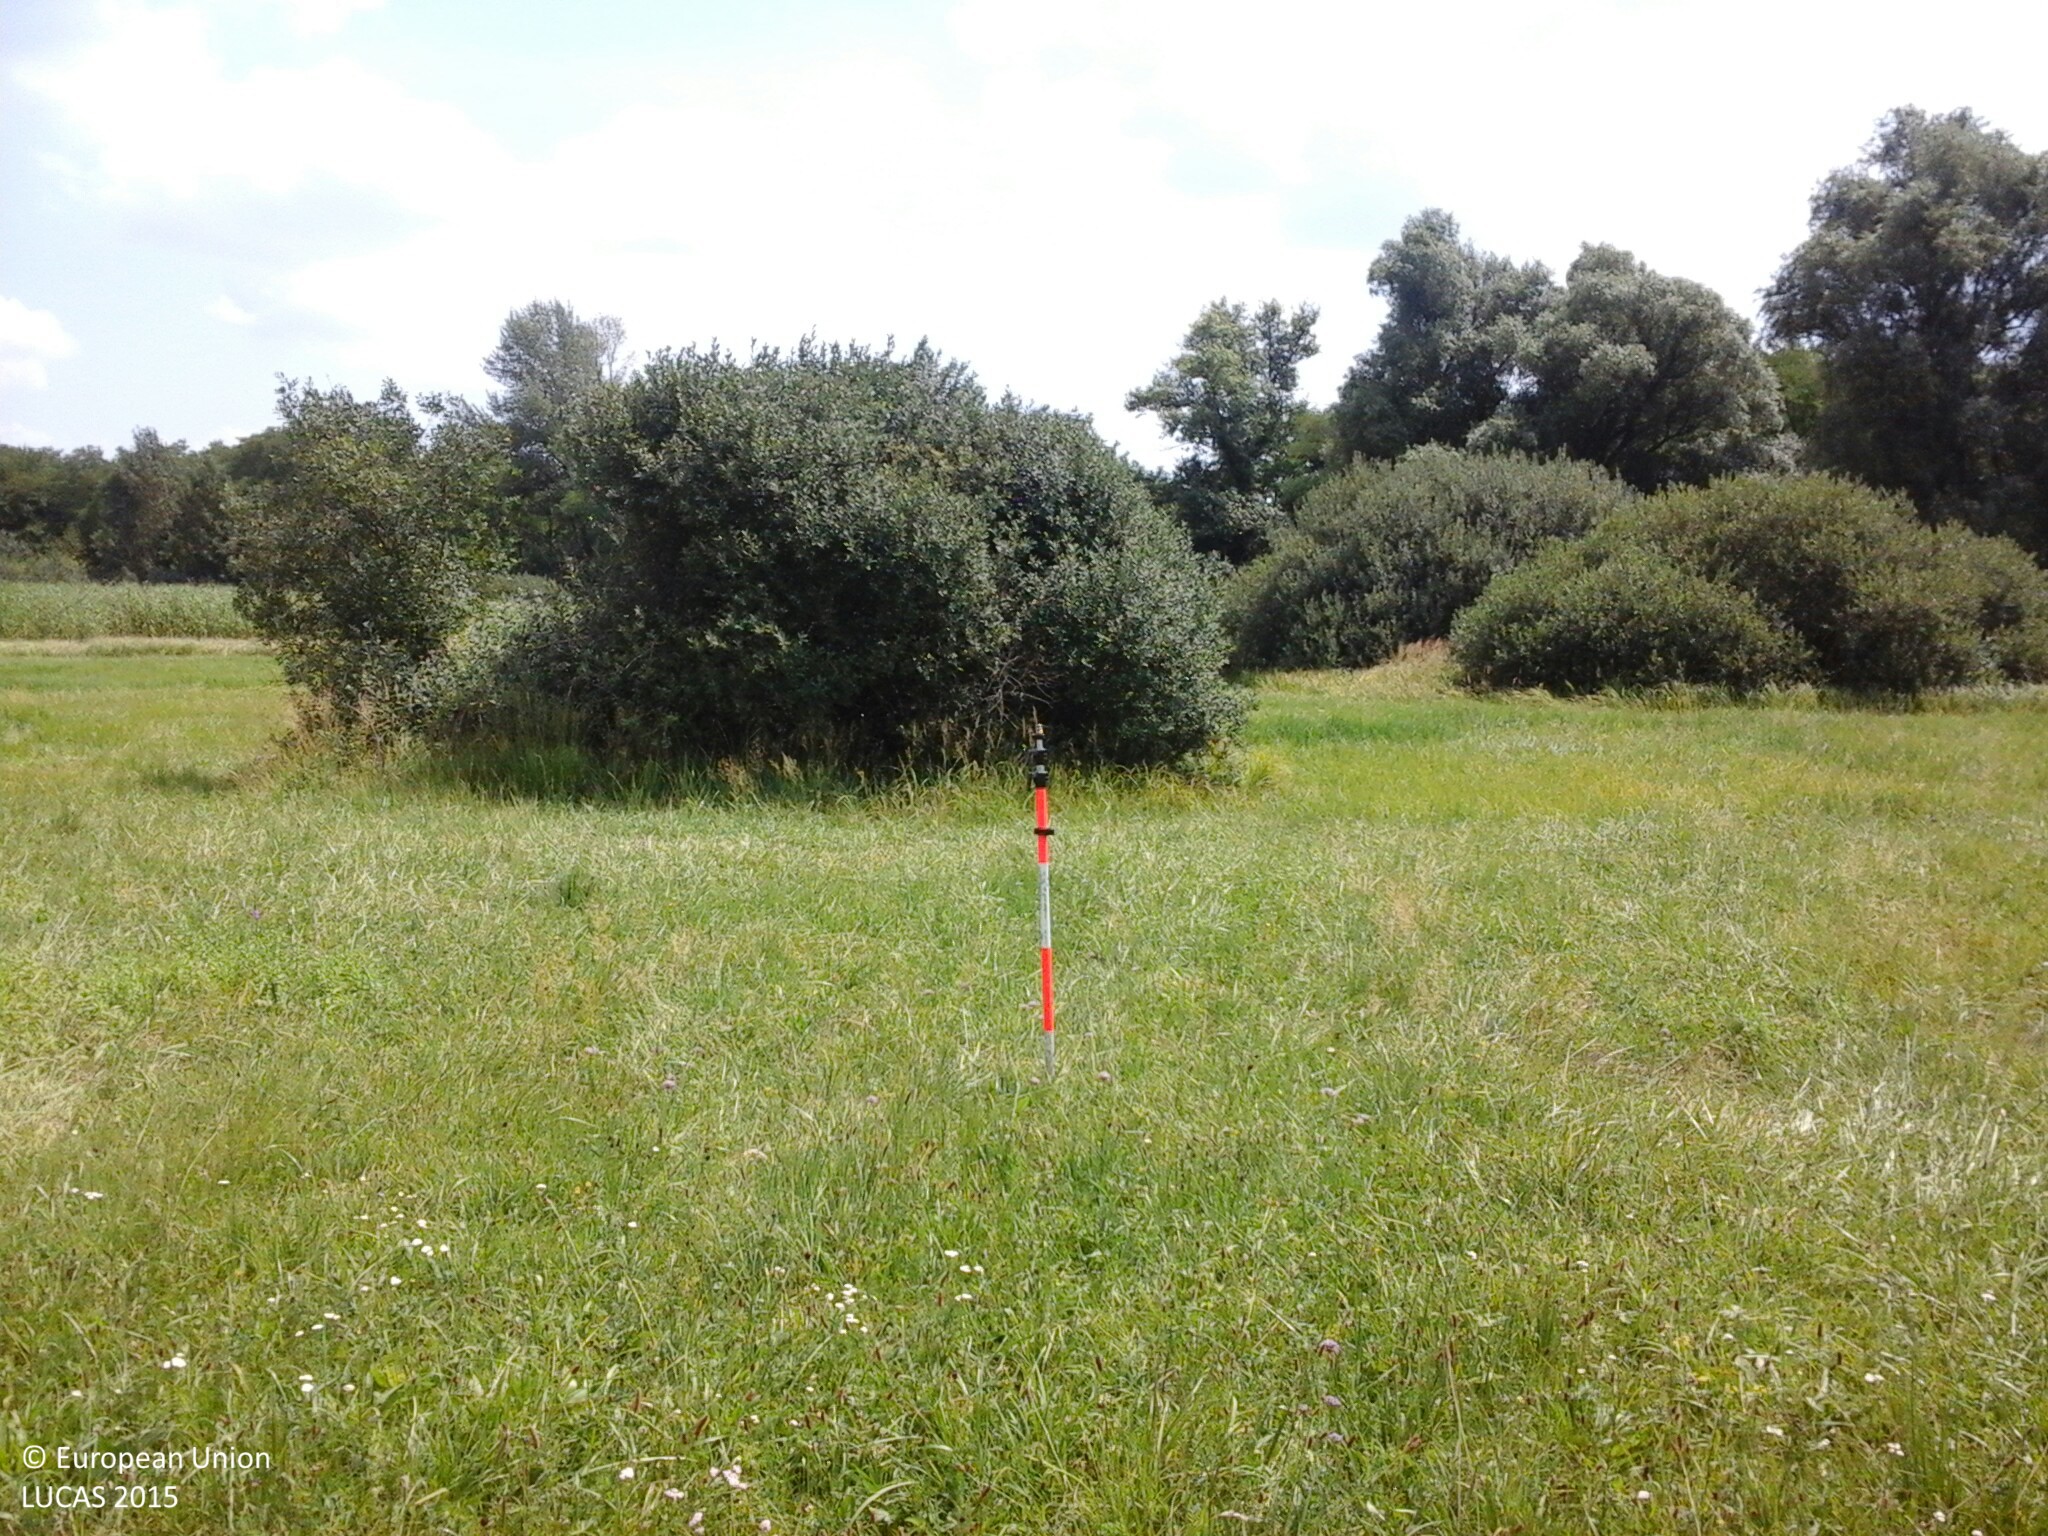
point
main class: Grassland
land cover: Grassland without tree/shrub cover
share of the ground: > 75 %
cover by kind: herbaceous plants 100 %
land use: Semi-natural and natural areas not in use
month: August
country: HU
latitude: 47.3565
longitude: 18.2066
